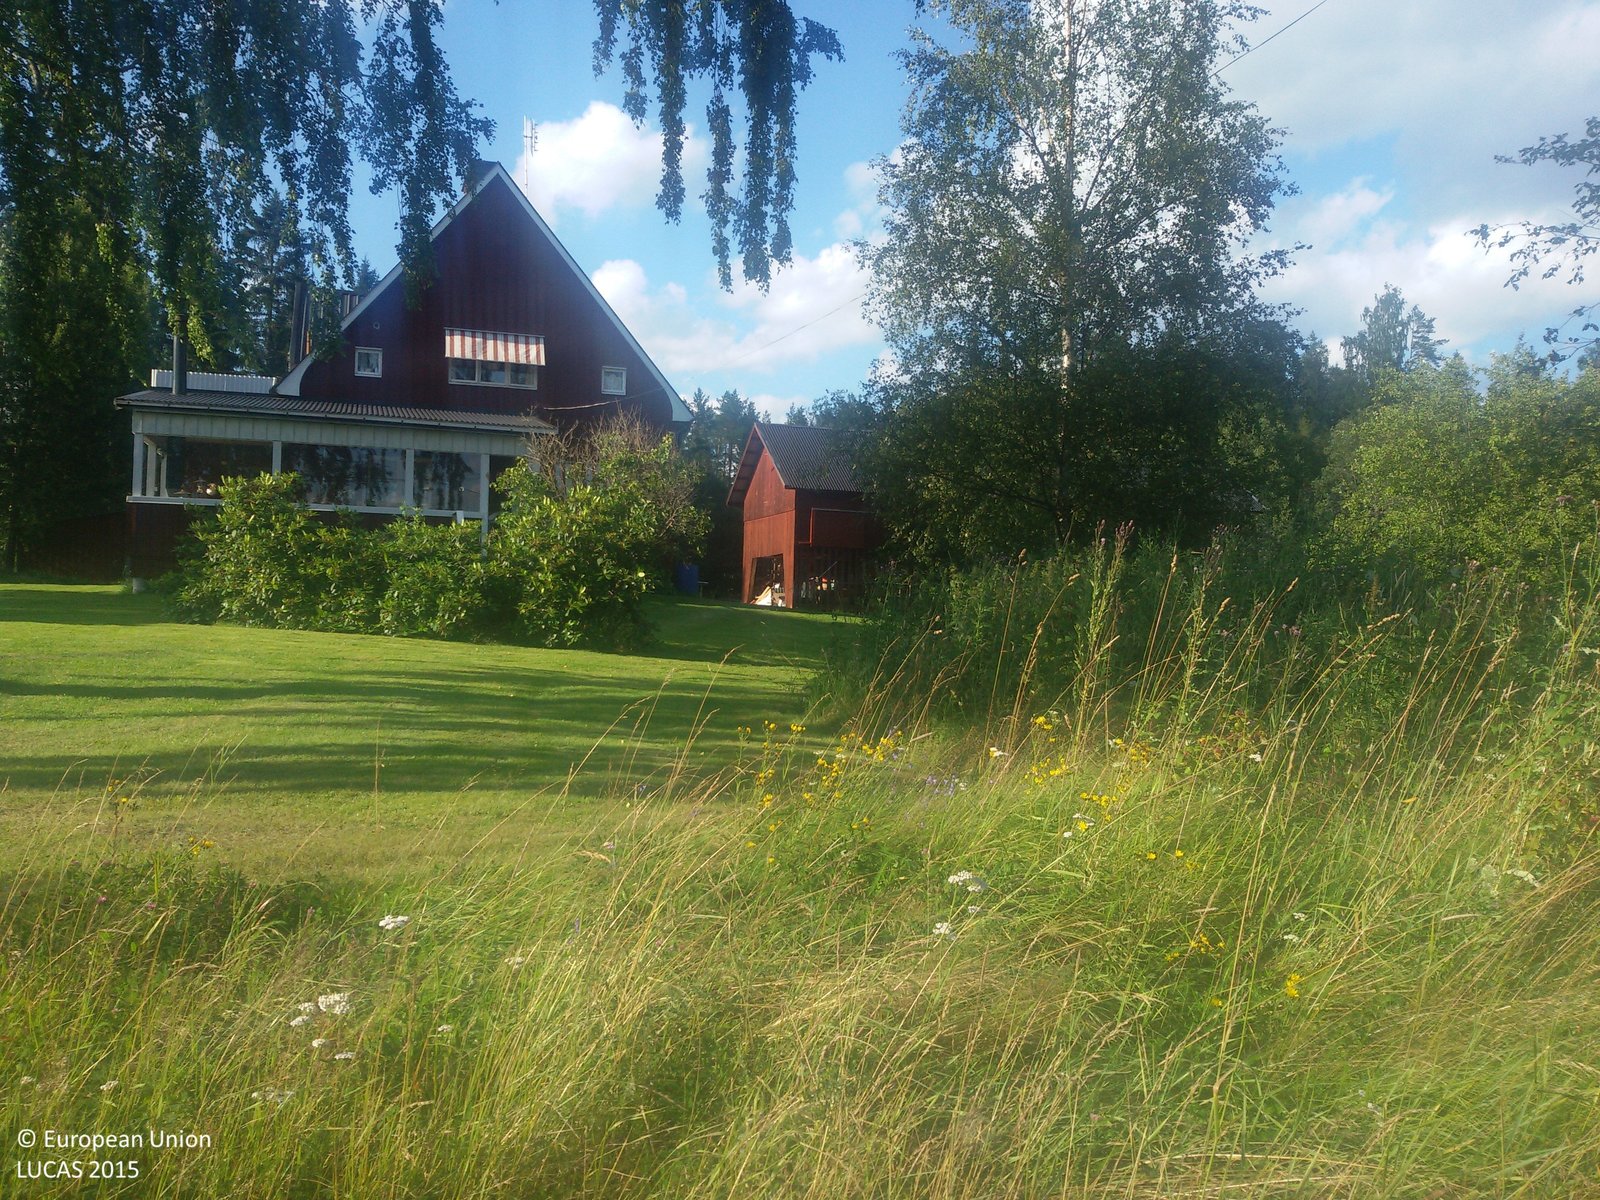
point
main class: Grassland
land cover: Grassland with sparse tree/shrub cover
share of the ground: > 75 %
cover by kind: herbaceous plants 95 %, broadleaved forest trees 5 %
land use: Residential
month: August
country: SE
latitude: 60.6020
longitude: 16.6543
